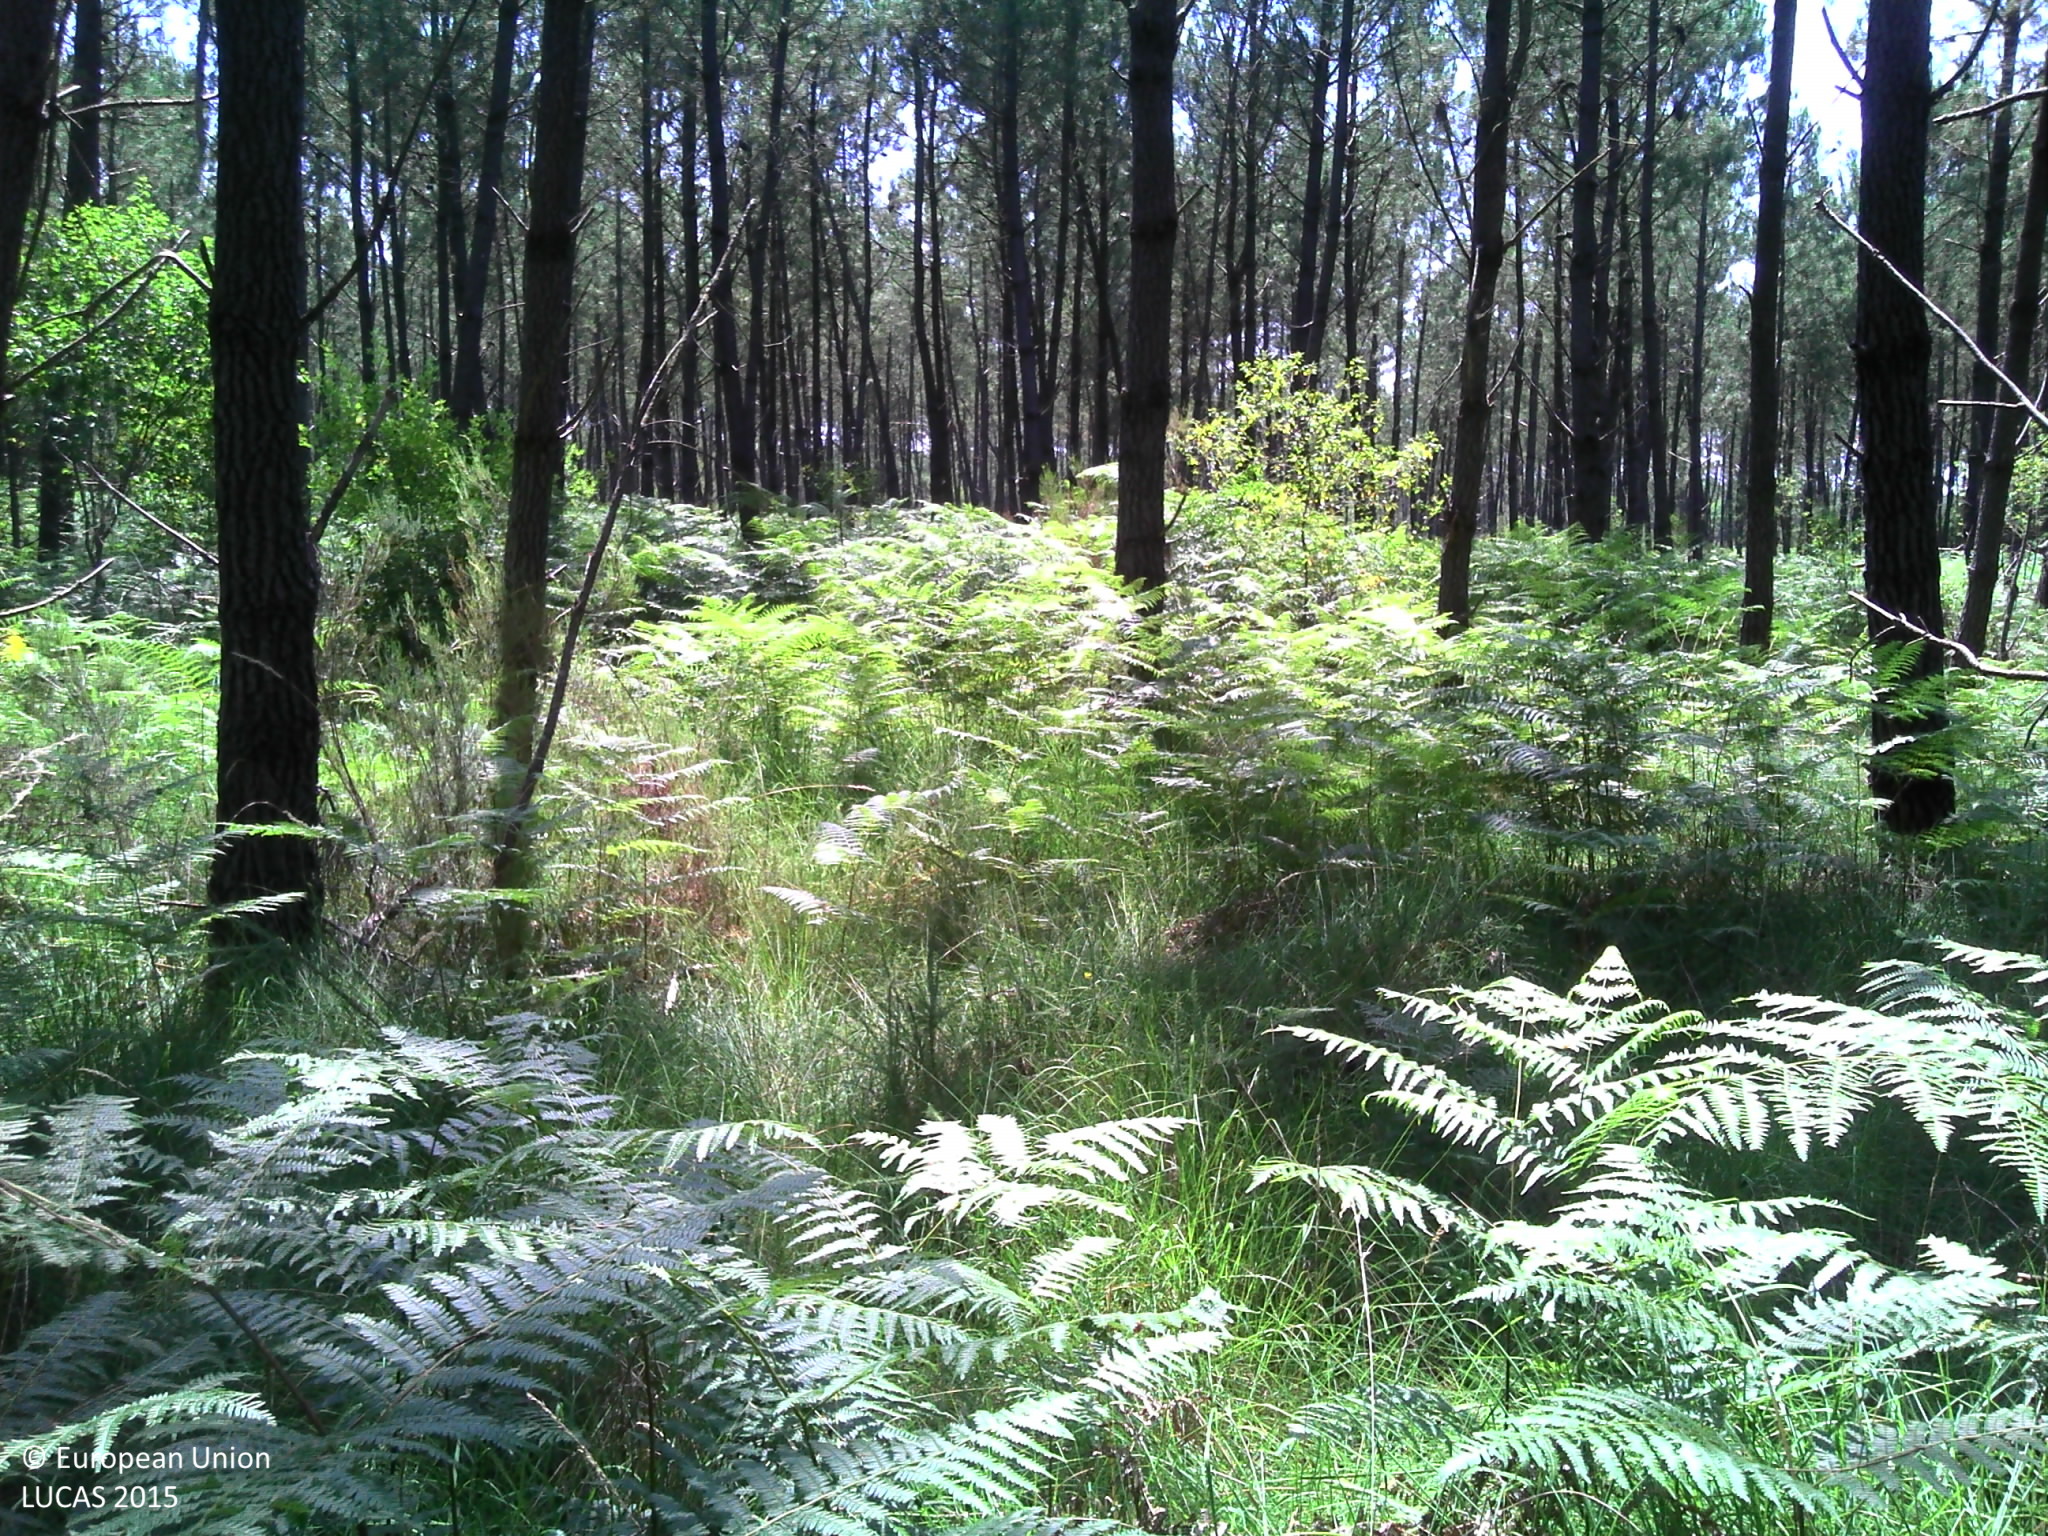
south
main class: Woodland
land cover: Pine dominated coniferous woodland
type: coniferous forest of the mediterranean region
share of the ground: > 75 %
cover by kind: coniferous forest trees 75 %, herbaceous plants 20 %, shrubs 5 %
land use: Forestry
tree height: > 5 m
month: July
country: FR
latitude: 44.2733
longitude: -0.6525
